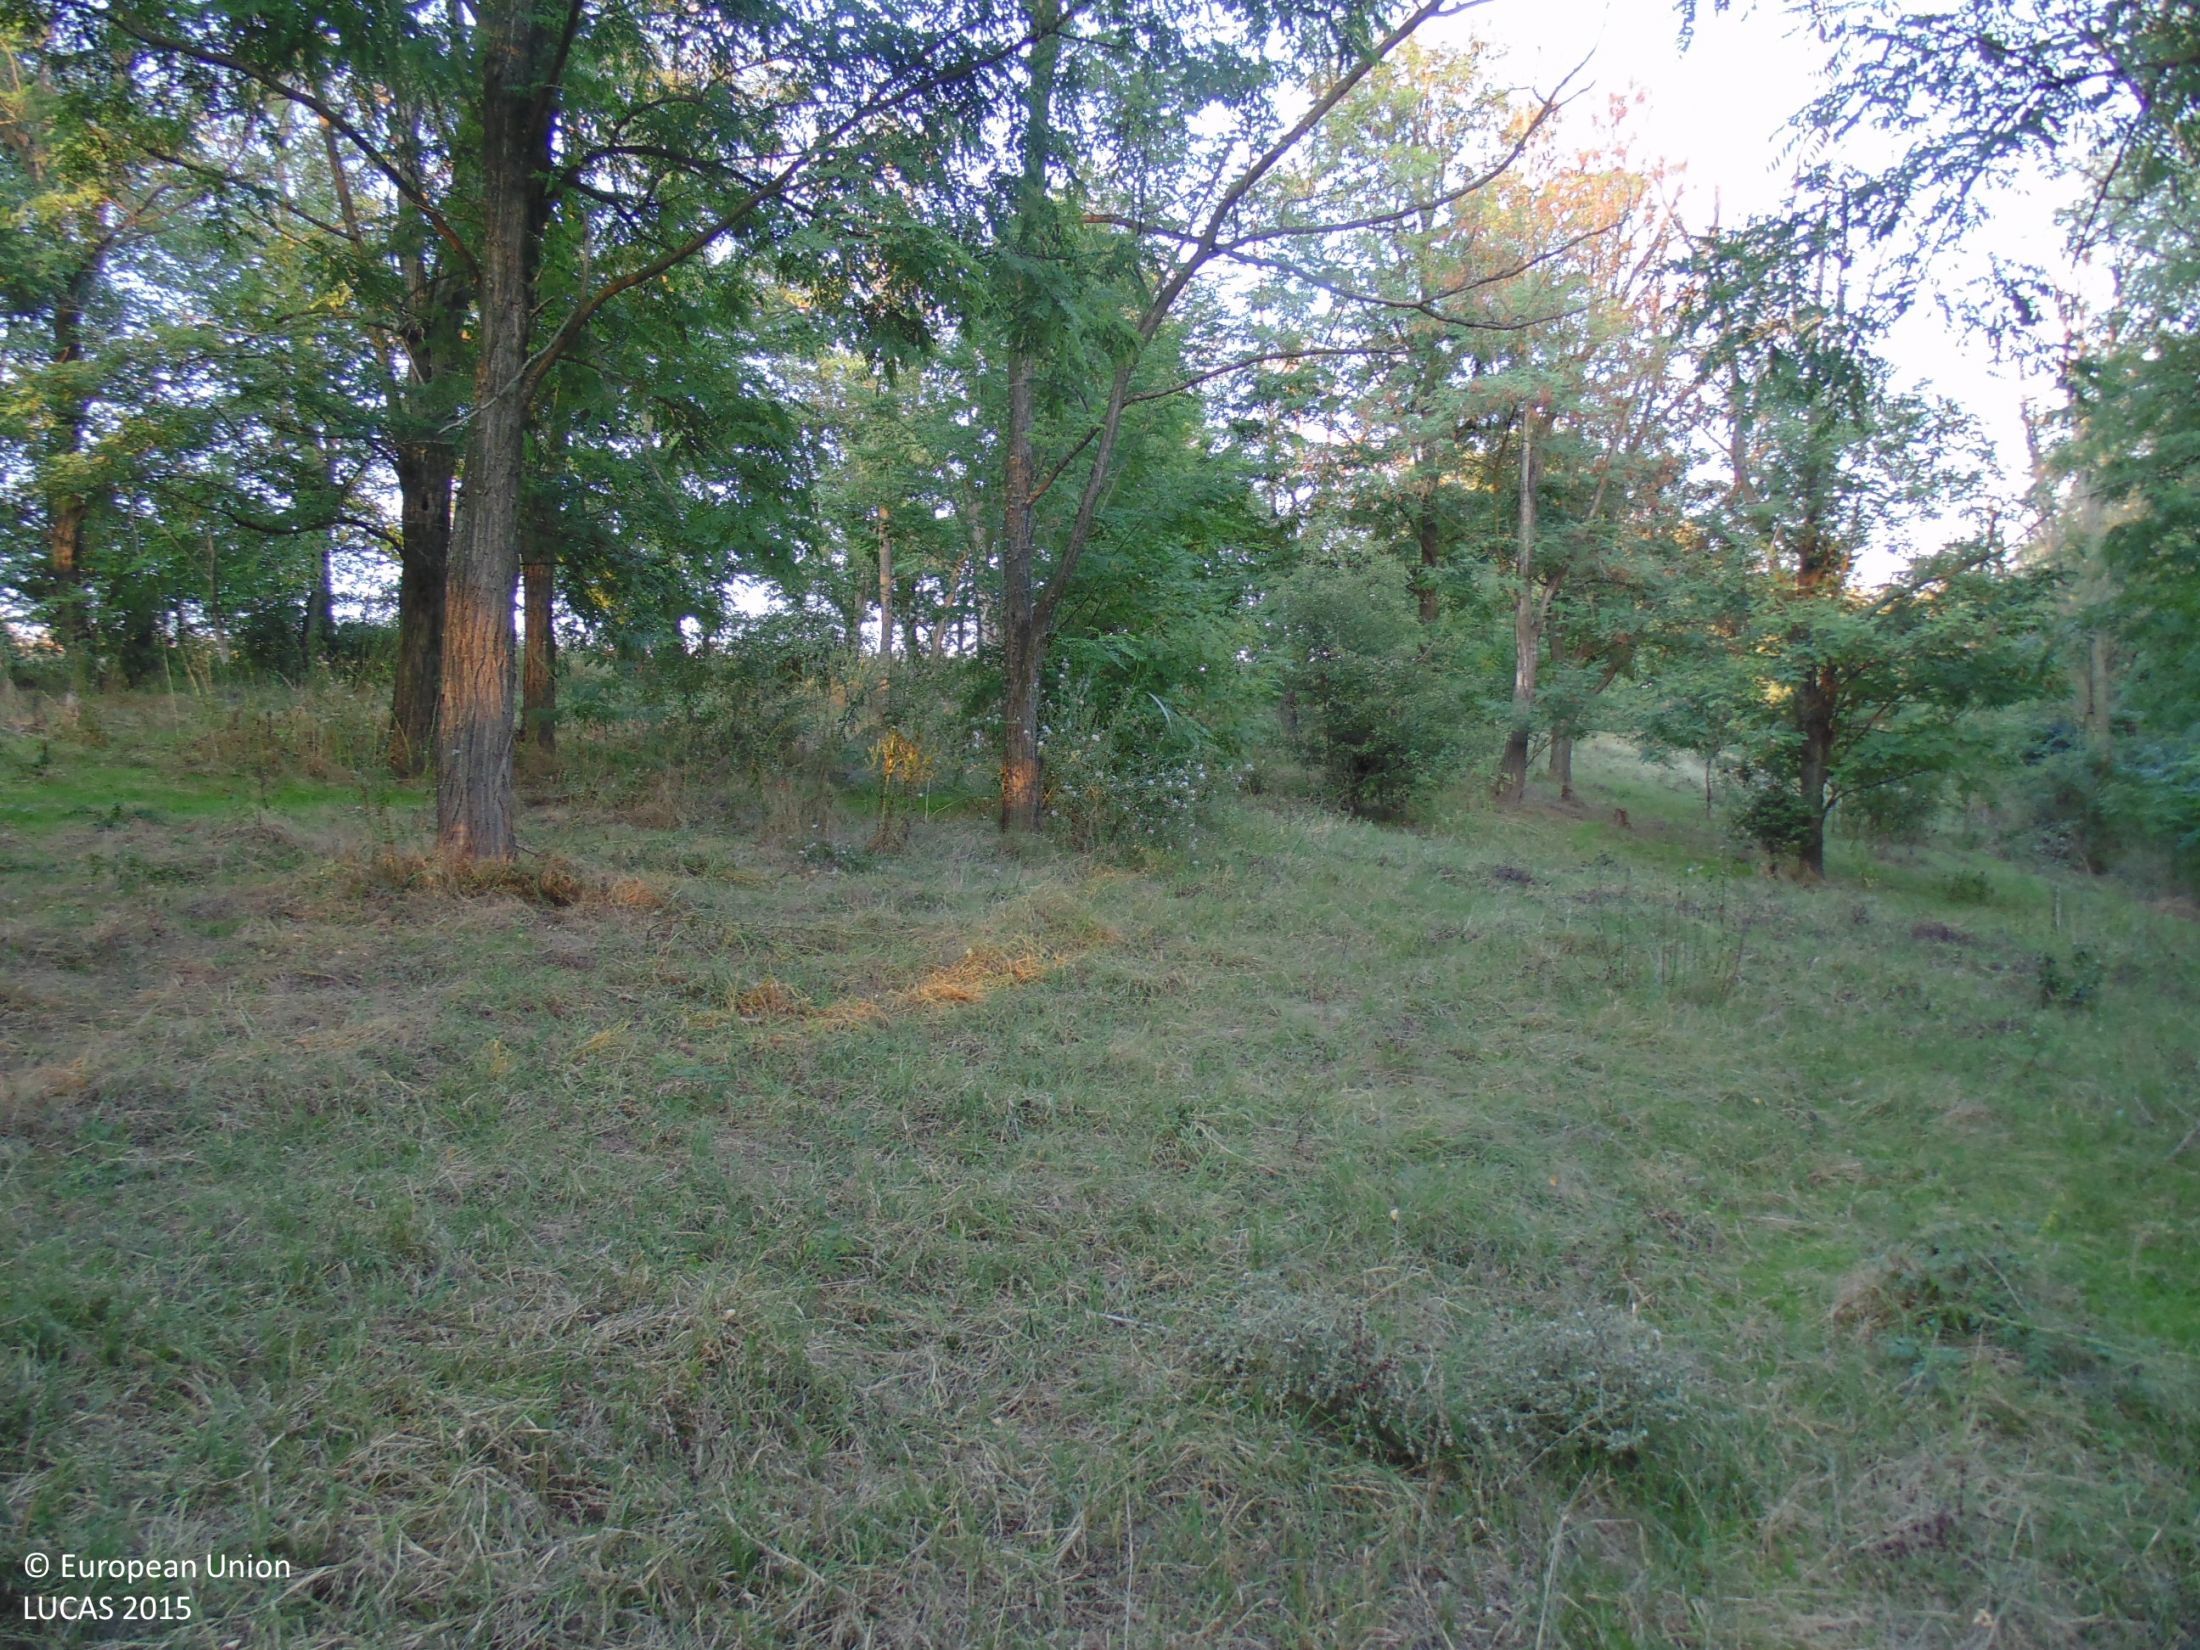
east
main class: Woodland
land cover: Broadleaved woodland
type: mesophytic deciduous forest
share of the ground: > 75 %
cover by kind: broadleaved forest trees 80 %, shrubs 15 %, unconsolidated bare surface 5 %
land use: Forestry
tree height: > 5 m
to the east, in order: Broadleaved woodland; Grass margins; Tracks; Maize; Grass margins; Sunflower
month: August
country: BG
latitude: 43.6805
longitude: 27.4868
